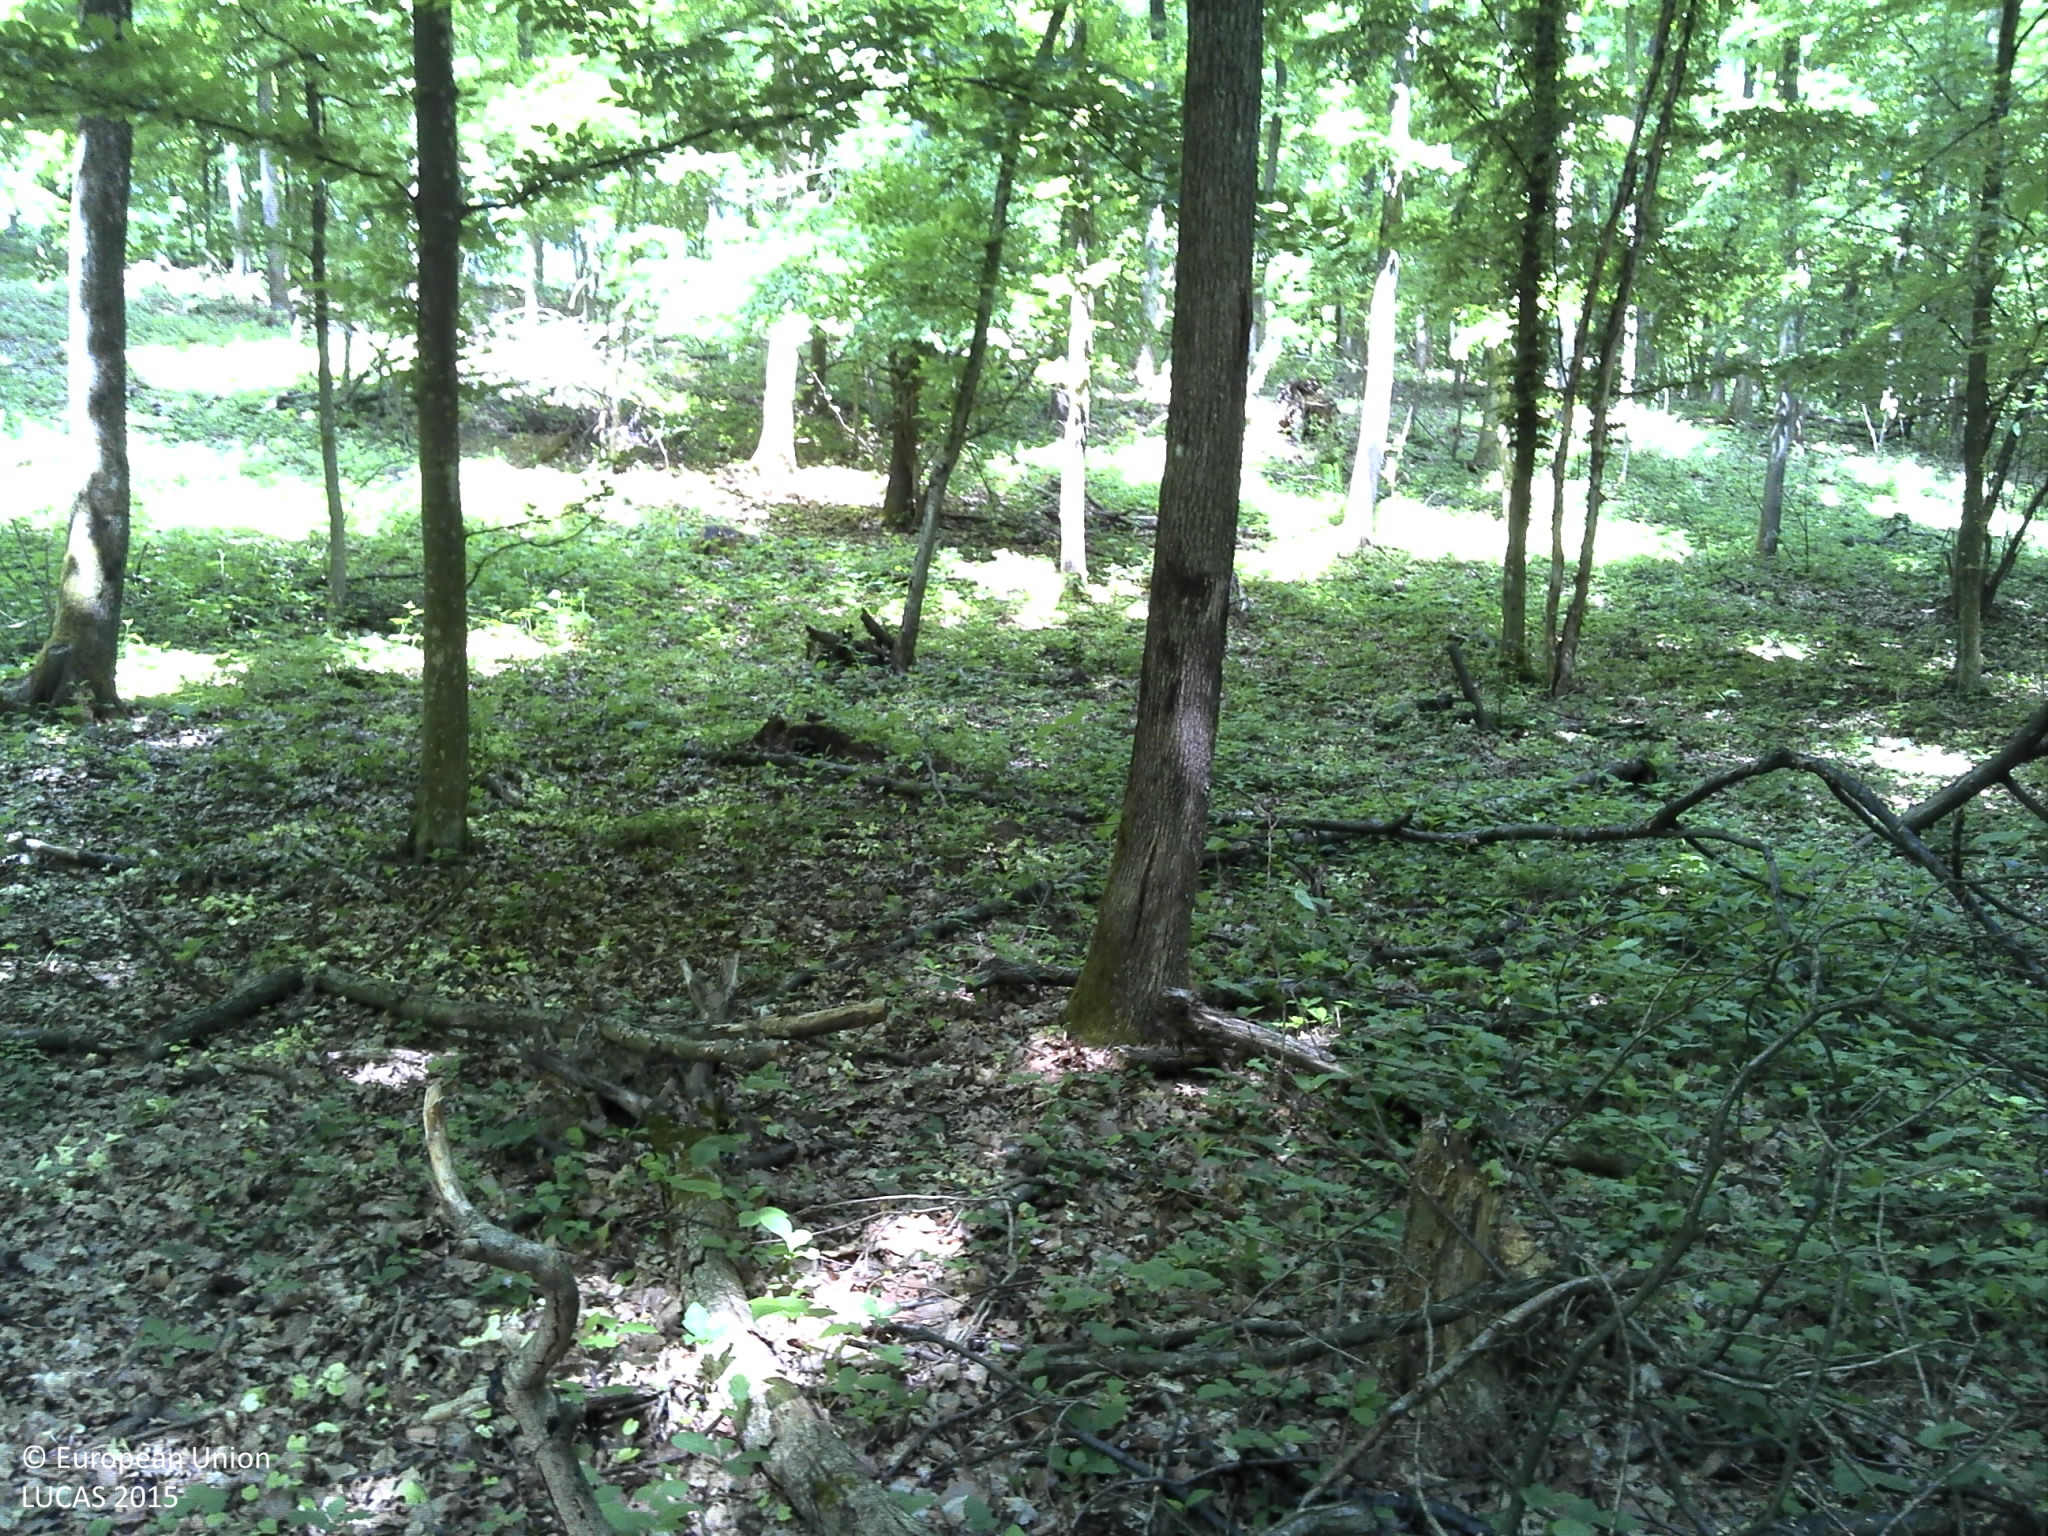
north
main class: Woodland
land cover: Broadleaved woodland
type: acidophilous oak and oak-birch forest
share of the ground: > 75 %
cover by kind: broadleaved forest trees 100 %
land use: Forestry
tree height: > 5 m
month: May
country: HR
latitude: 45.4048
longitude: 18.1681
